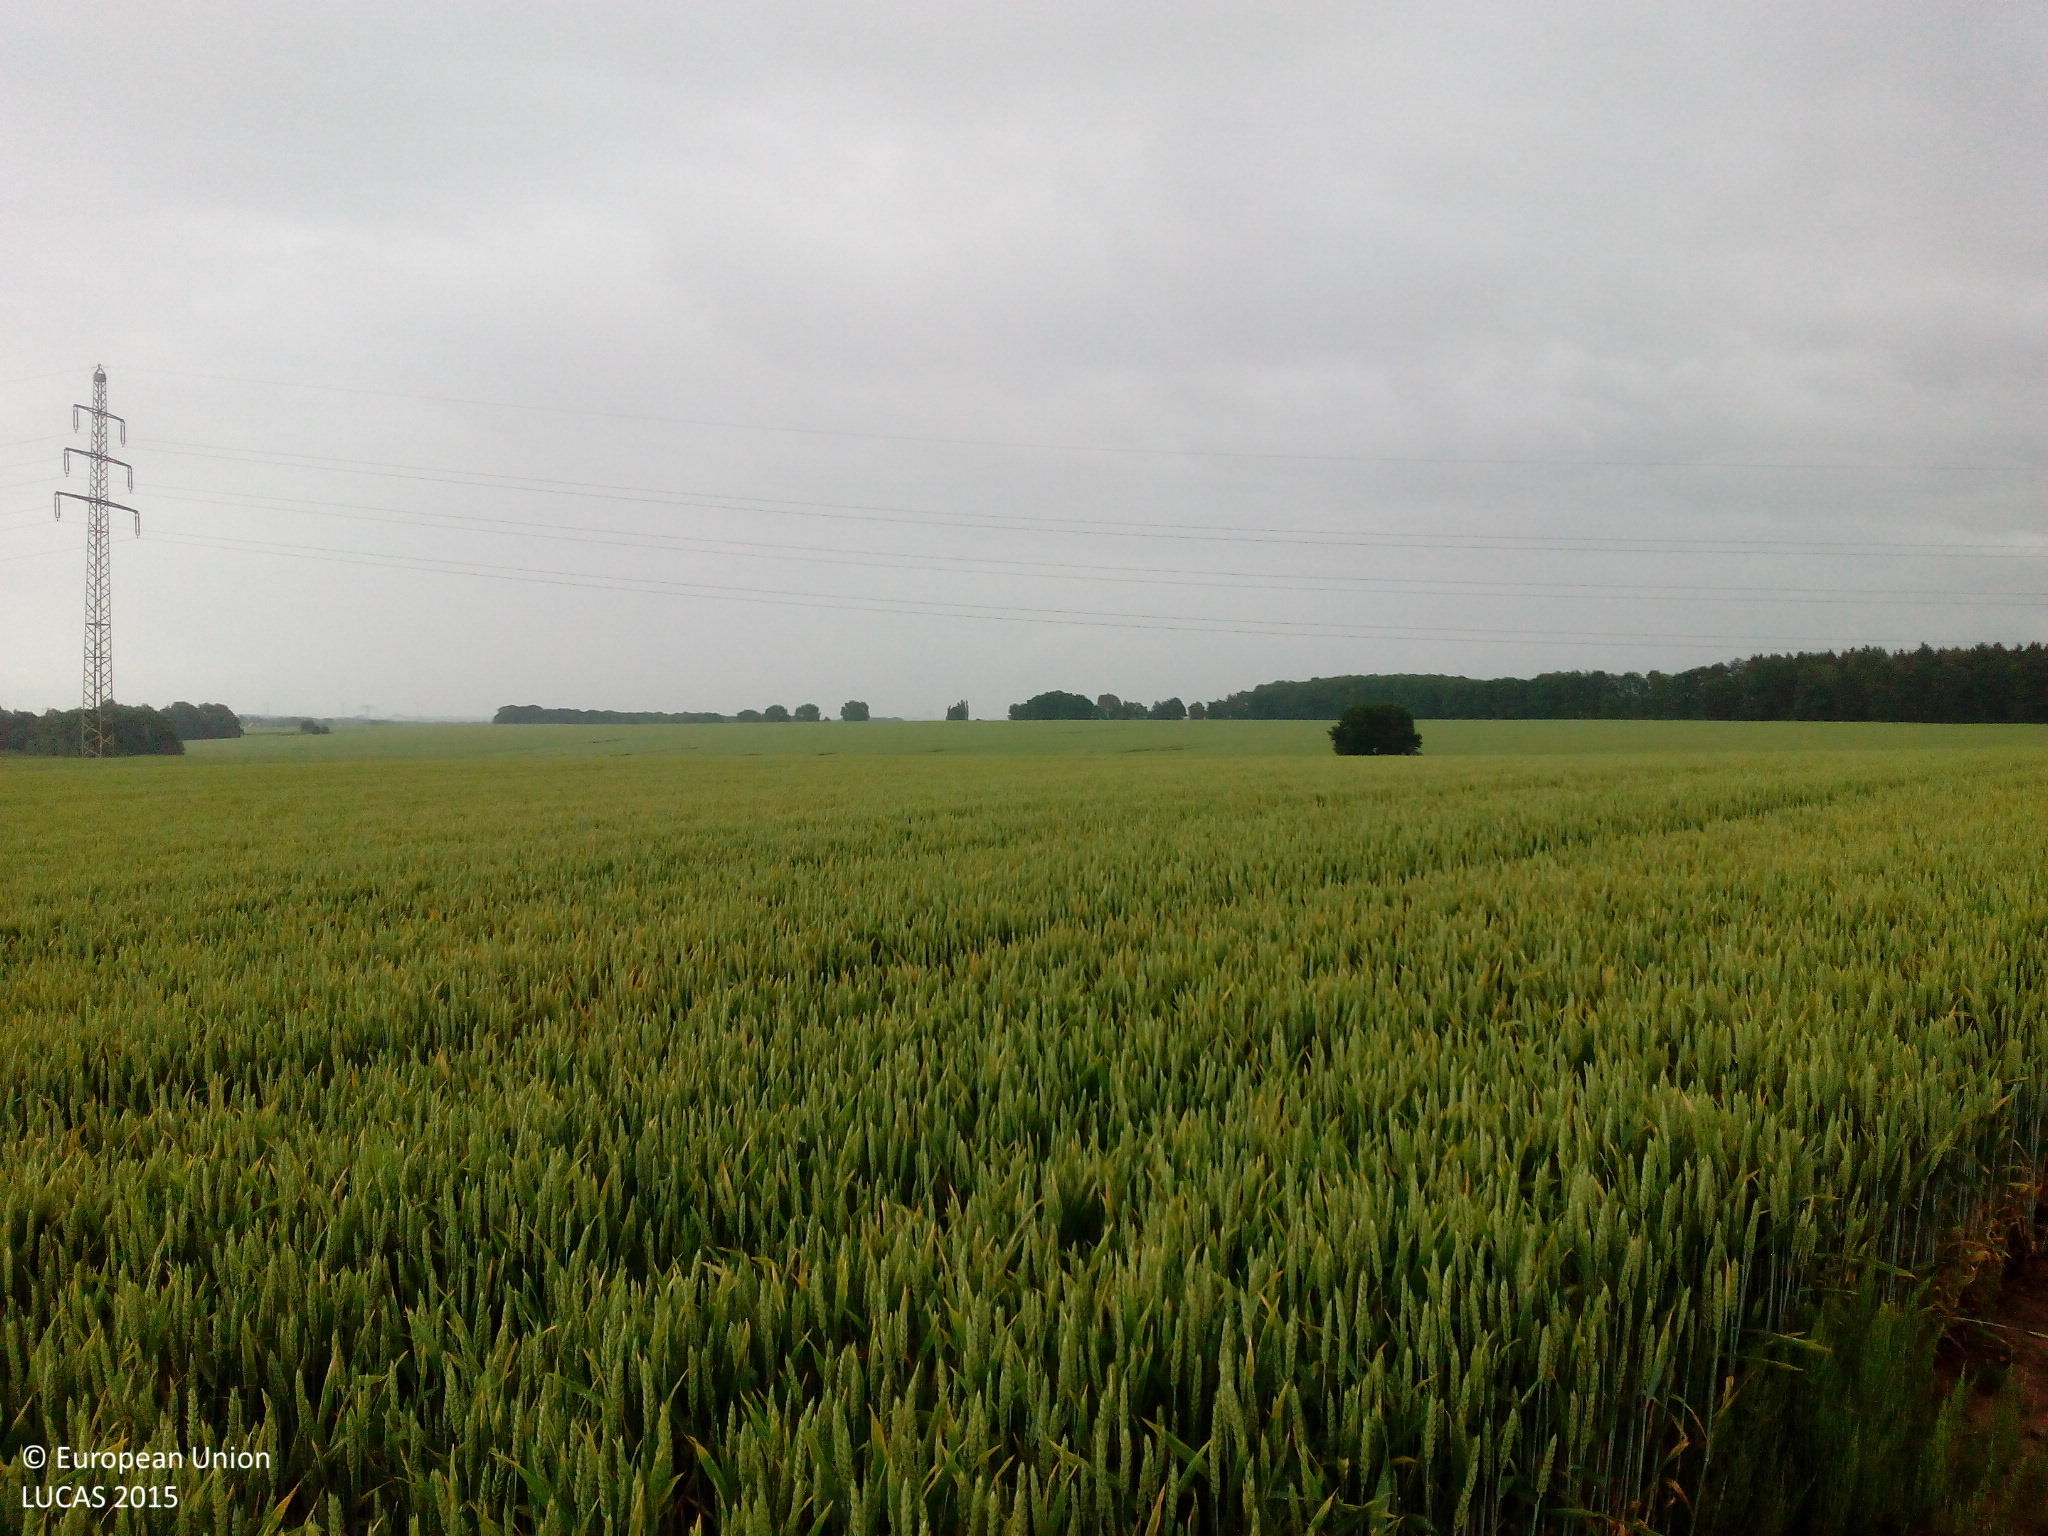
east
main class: Cropland
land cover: Common wheat
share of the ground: > 75 %
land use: Agriculture (excluding fallow land and kitchen gardens)
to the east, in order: Common wheat; Tracks; Common wheat; Electric lines; Common wheat
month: June
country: DE
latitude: 51.0060
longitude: 13.0927
